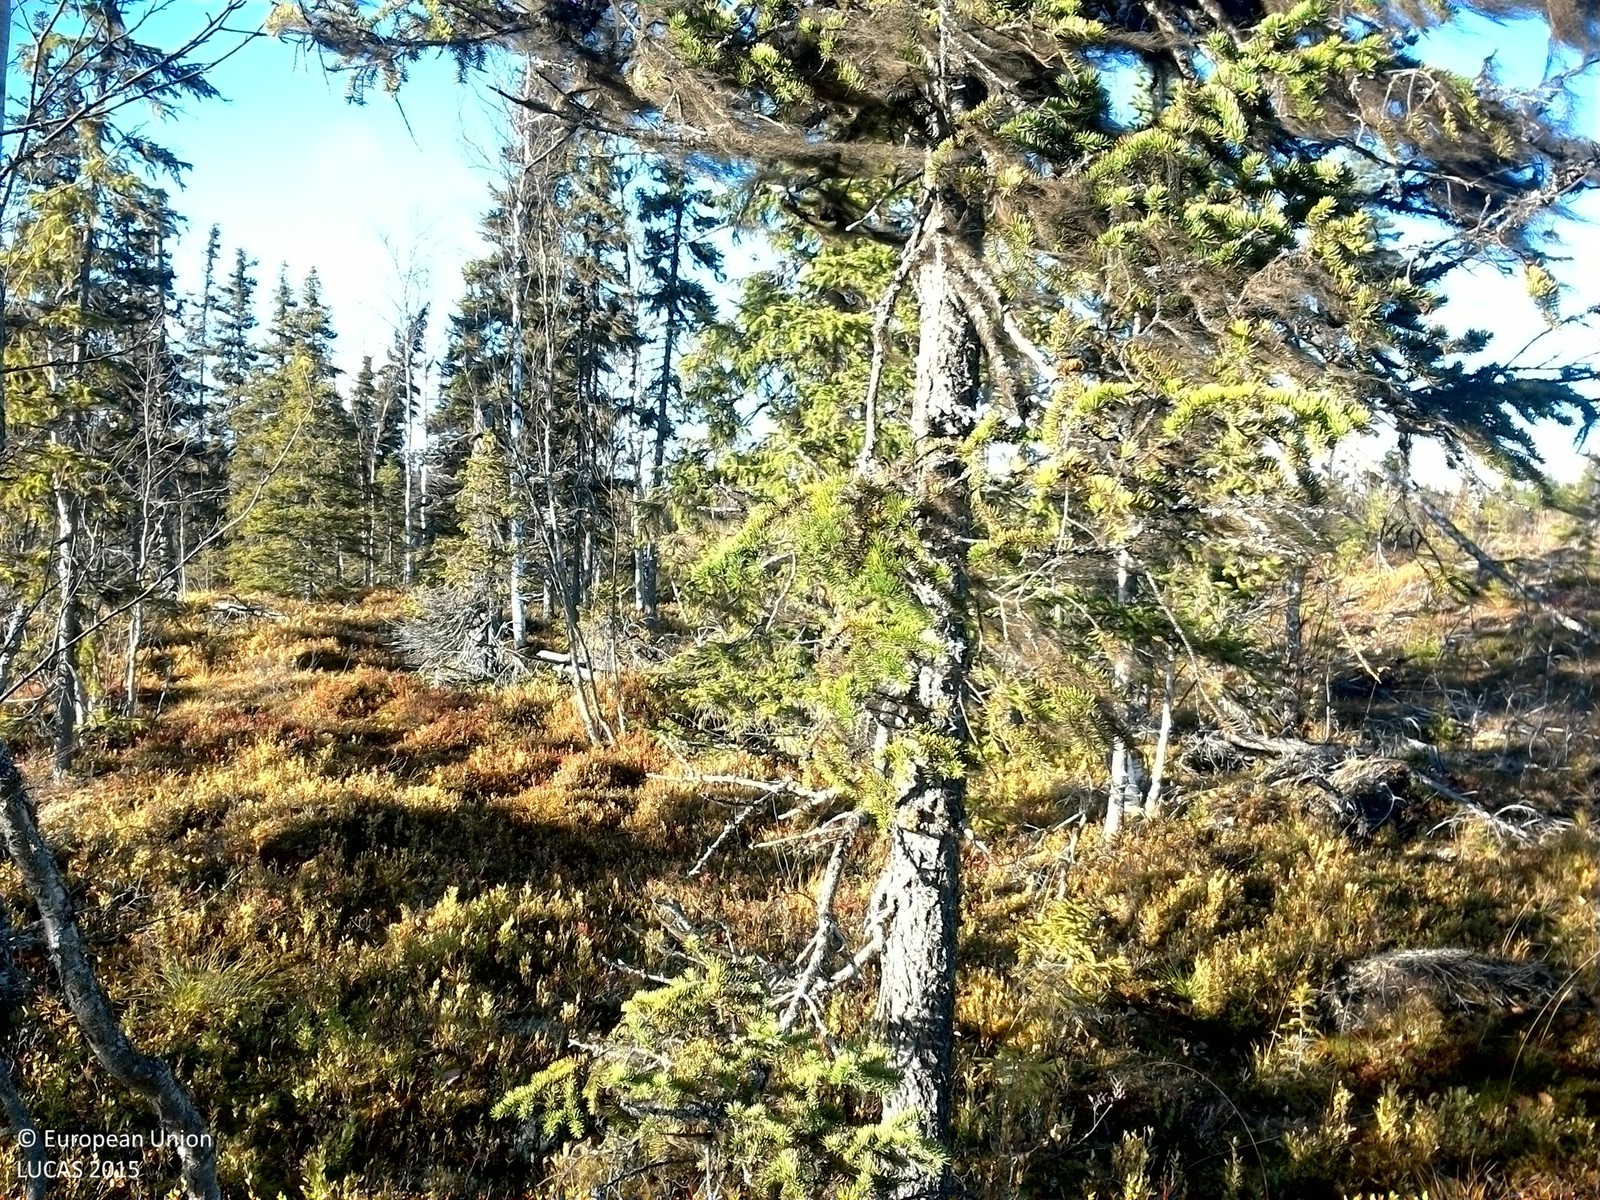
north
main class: Woodland
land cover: Spruce dominated mixed woodland
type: boreal forest
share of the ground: 25 - 50 %
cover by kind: shrubs 45 %, coniferous forest trees 25 %, broadleaved forest trees 15 %, lichens and mosses 15 %
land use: Forestry
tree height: > 5 m
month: October
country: SE
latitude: 64.1909
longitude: 16.0845
